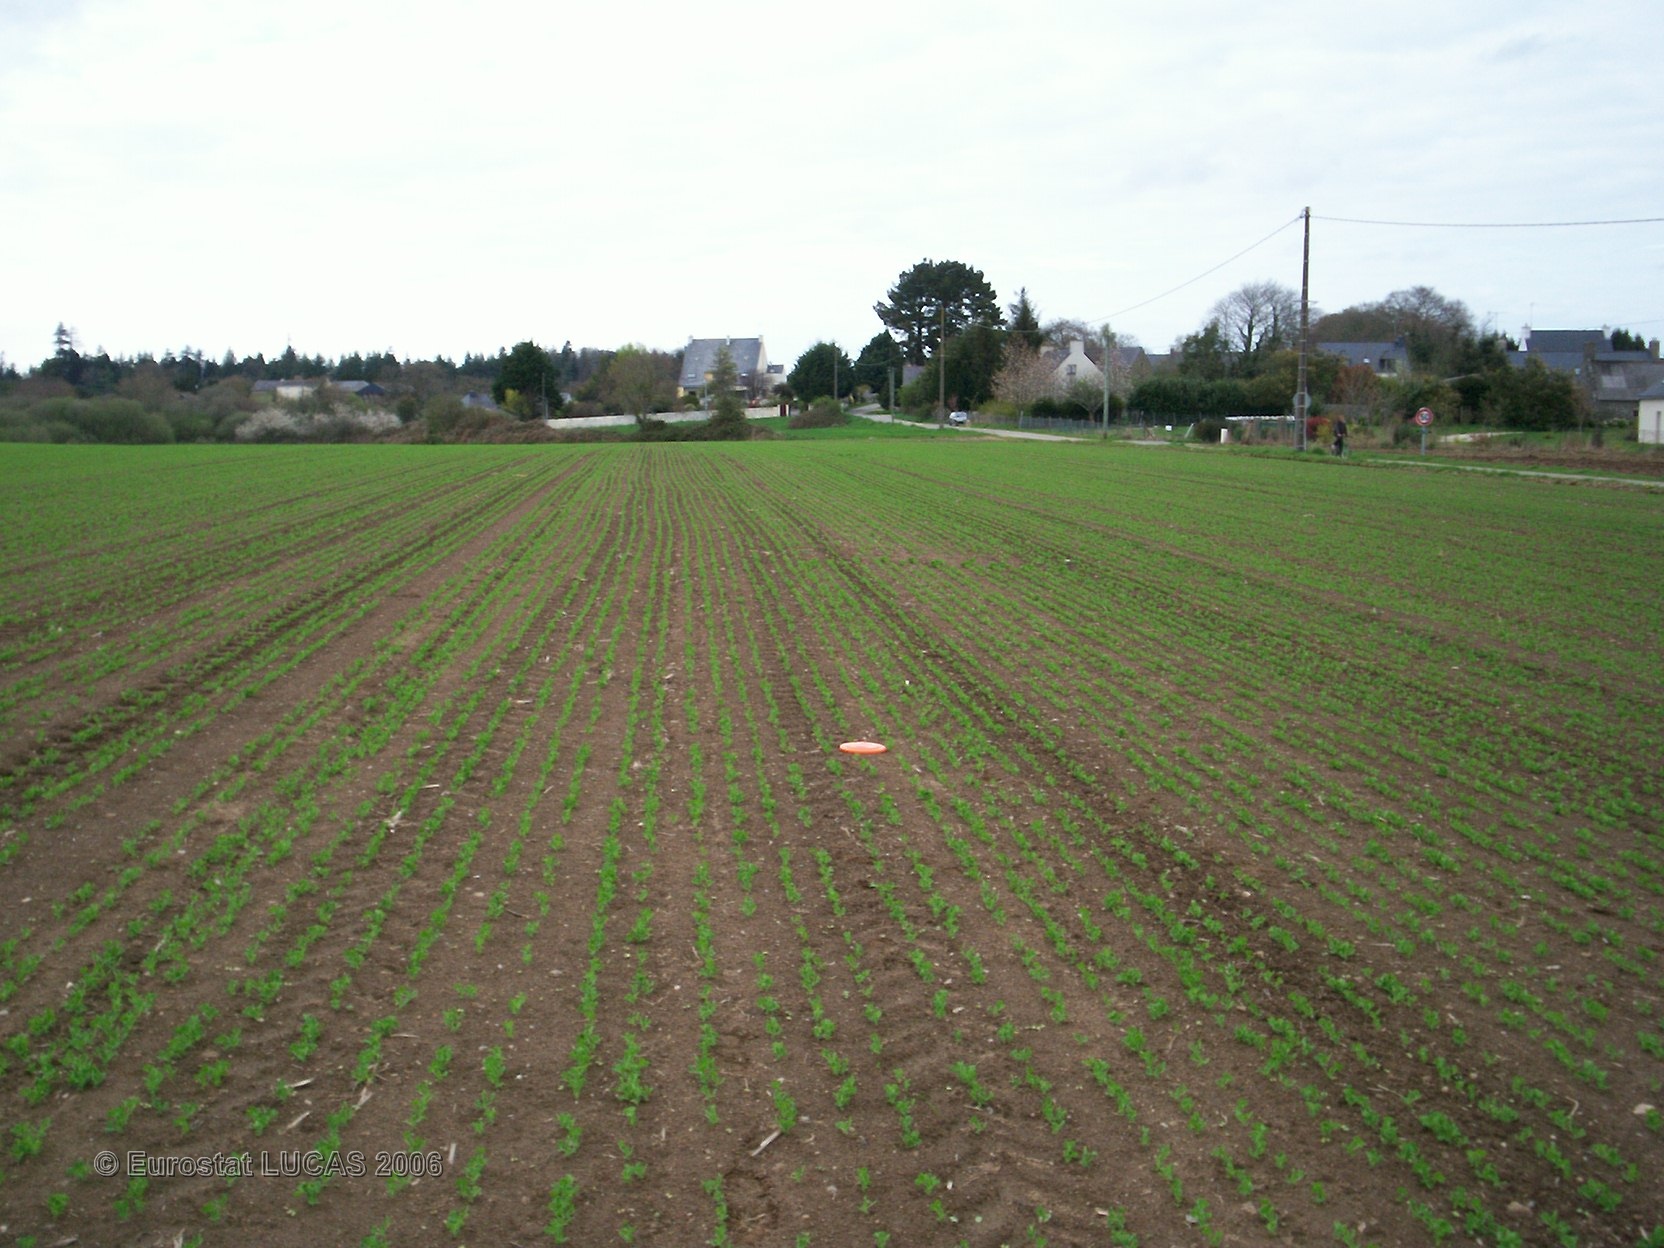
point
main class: Cropland
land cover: Dry pulses
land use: Agriculture (excluding fallow land and kitchen gardens)
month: April
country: FR
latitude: 47.8229
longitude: -3.5267
